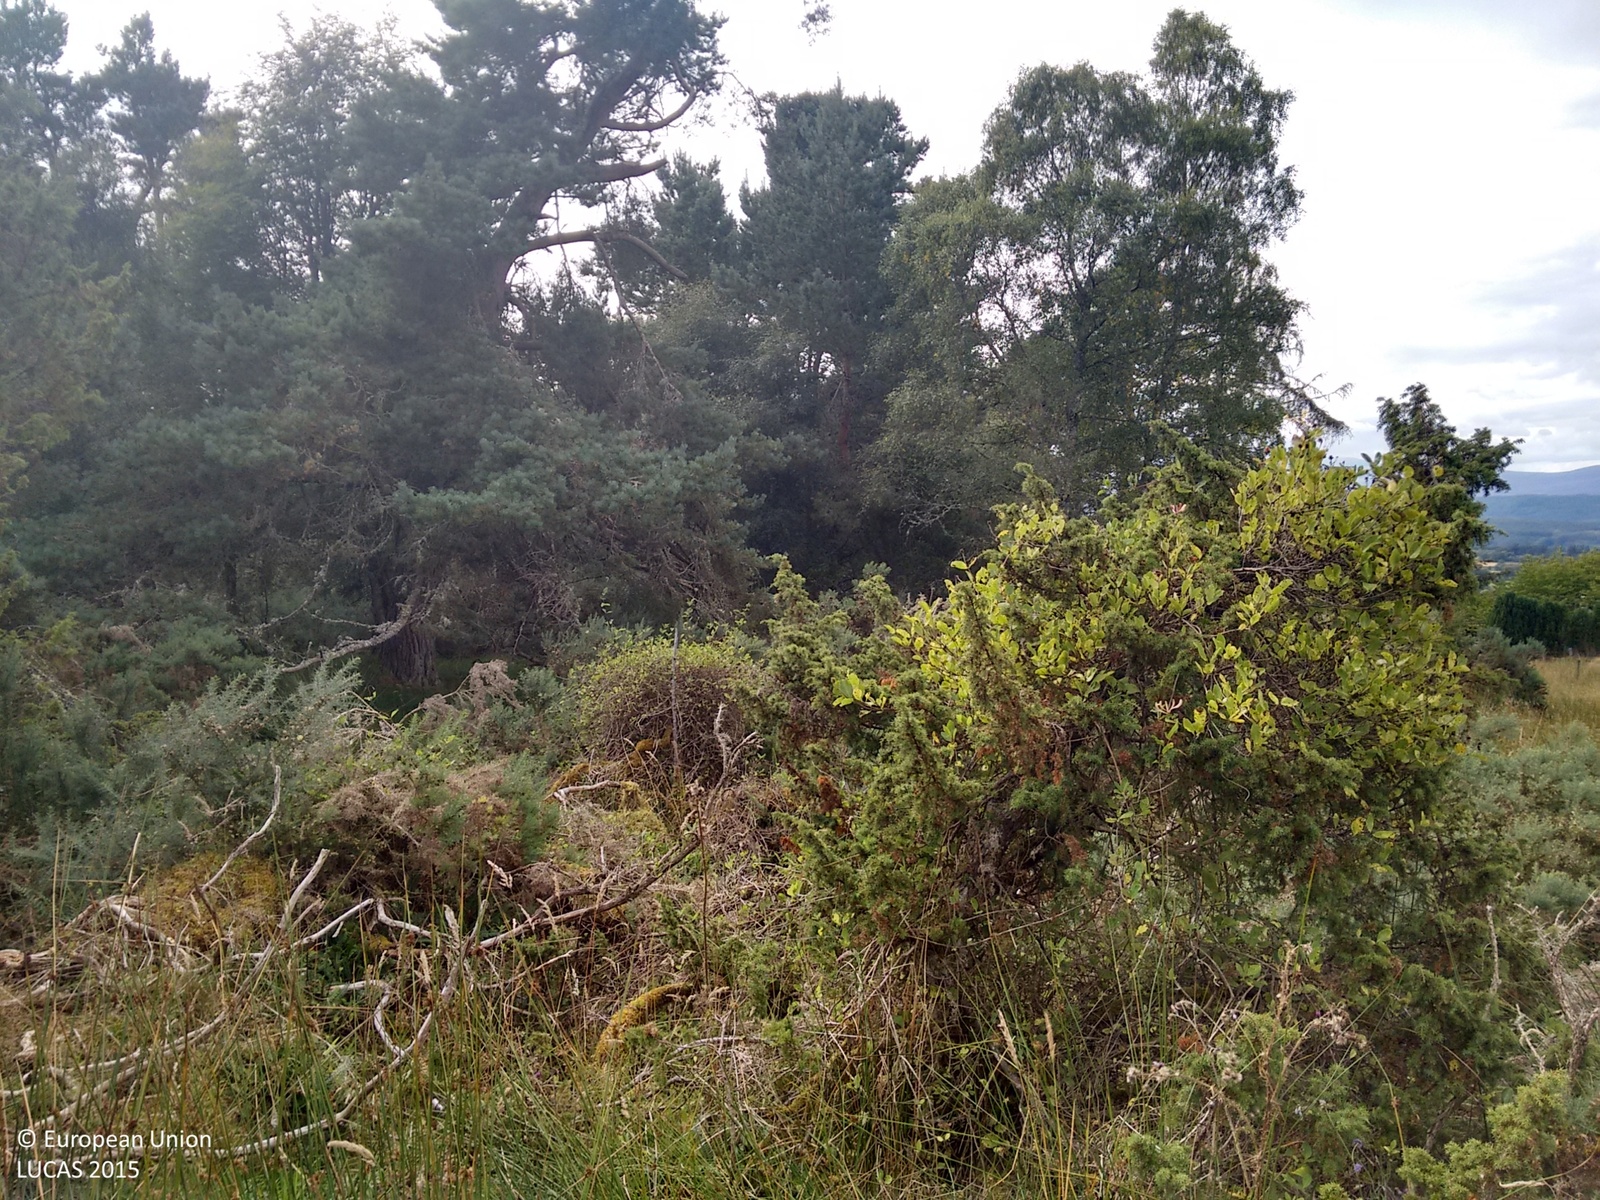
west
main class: Woodland
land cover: Other mixed woodland
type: exotic forest
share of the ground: > 75 %
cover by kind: coniferous forest trees 45 %, broadleaved forest trees 30 %, shrubs 25 %
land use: Agriculture (excluding fallow land and kitchen gardens)
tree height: > 5 m
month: September
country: GB
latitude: 57.4135
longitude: -4.4576
